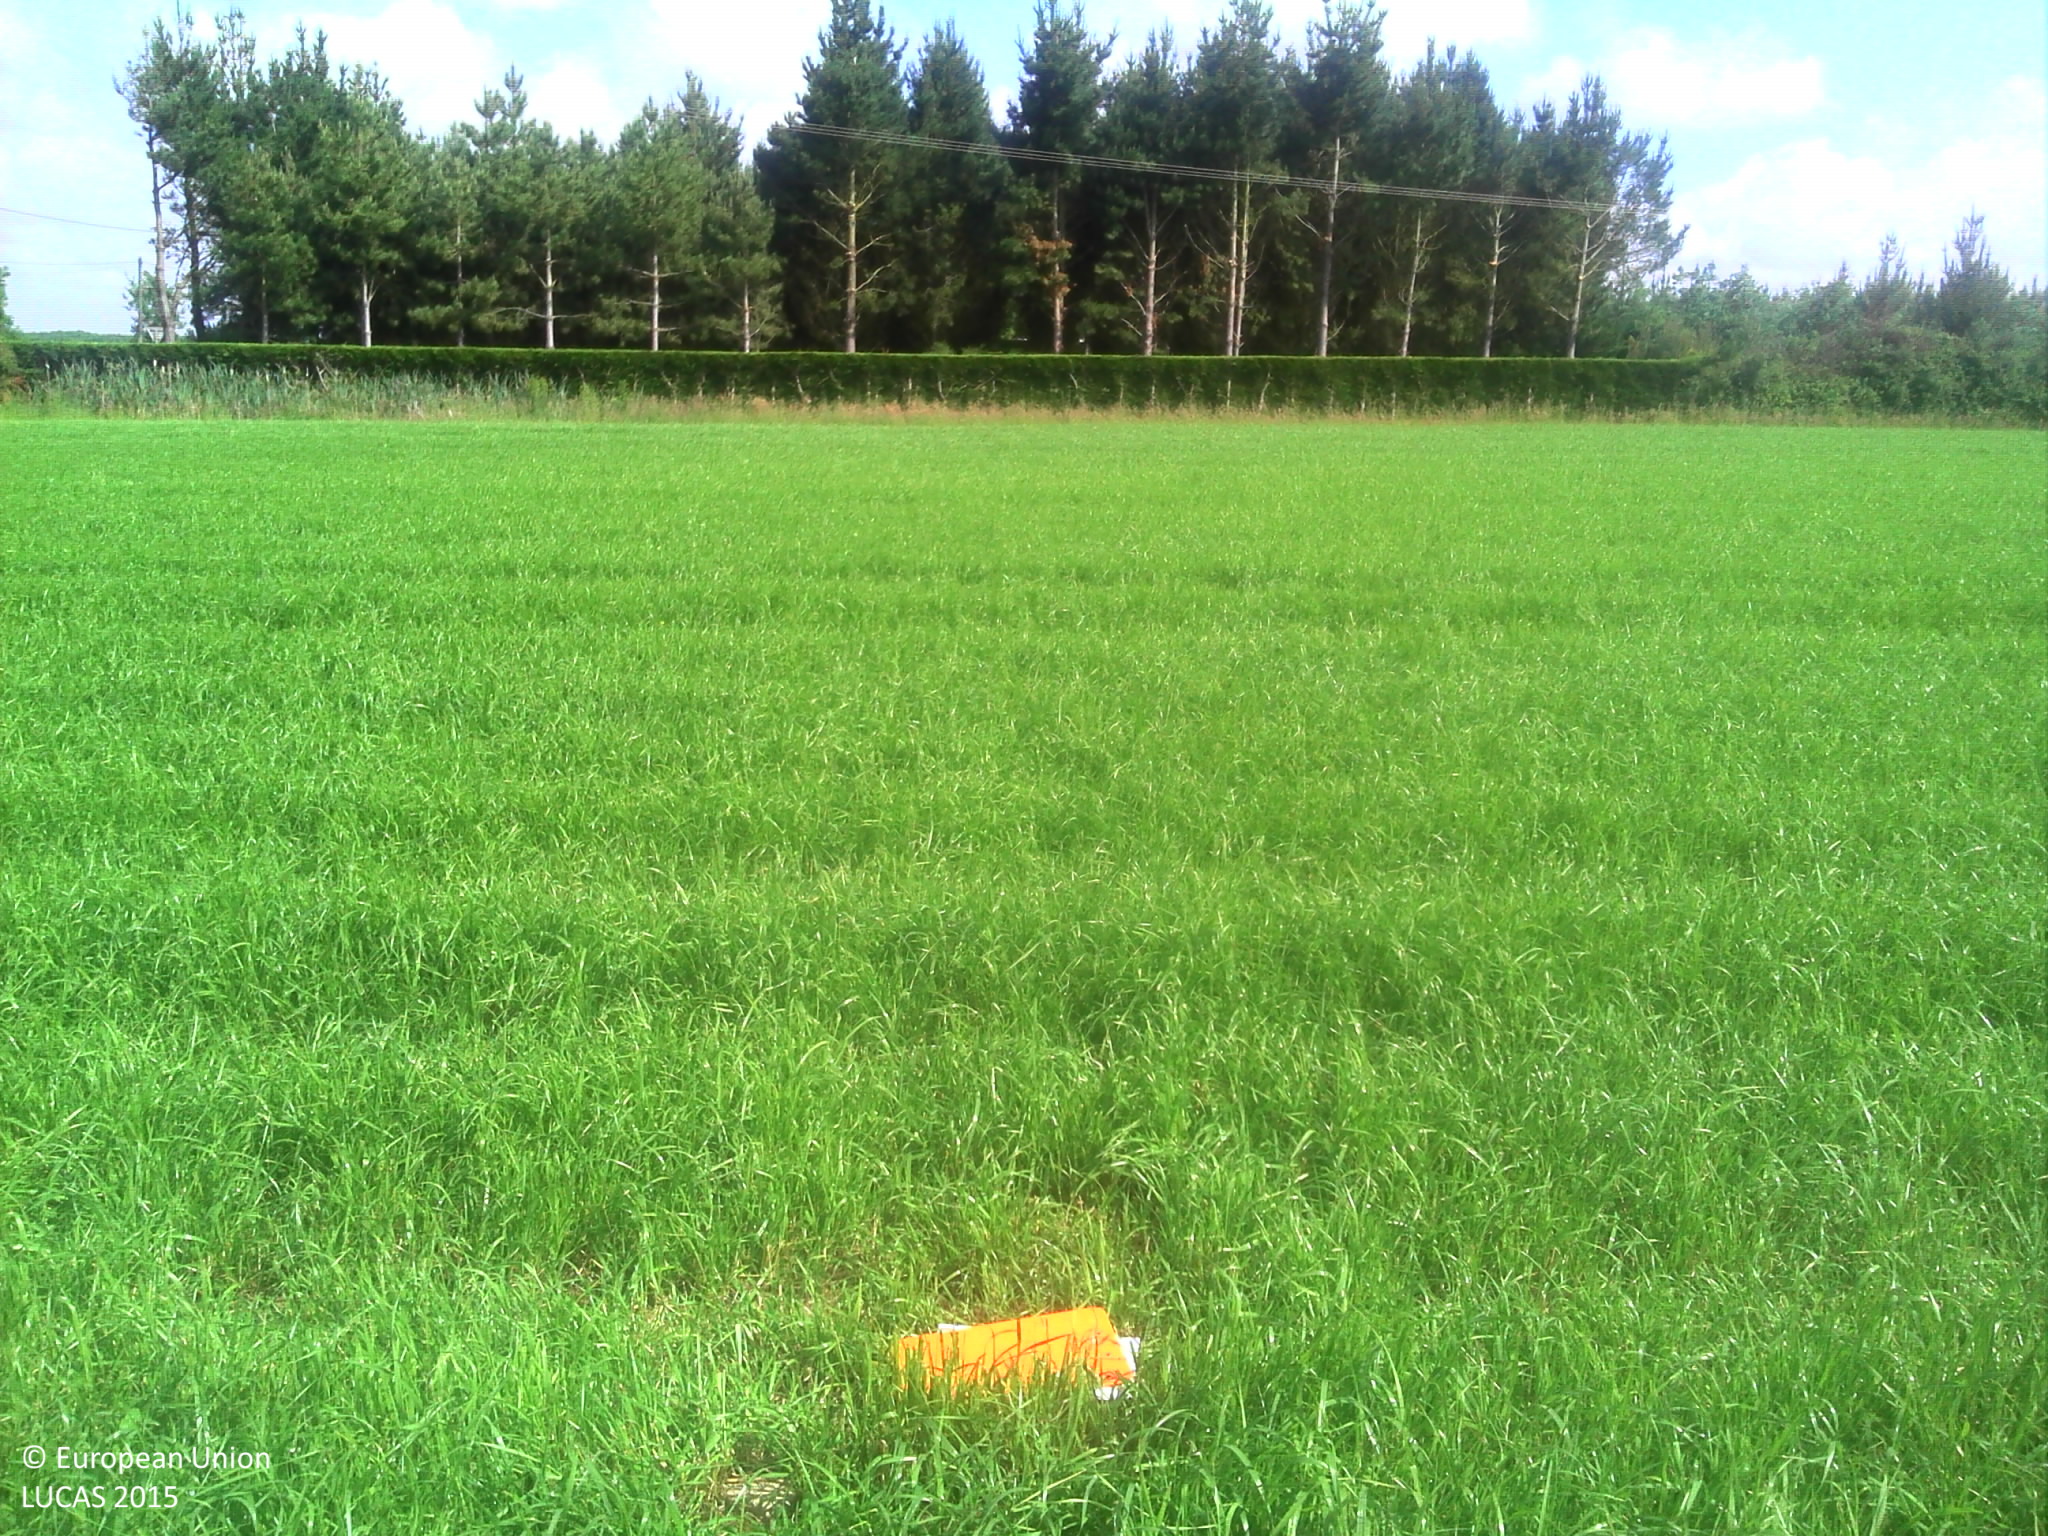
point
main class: Cropland
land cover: Temporary grasslands
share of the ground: > 75 %
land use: Agriculture (excluding fallow land and kitchen gardens)
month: May
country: FR
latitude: 47.4733
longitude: -0.9828
